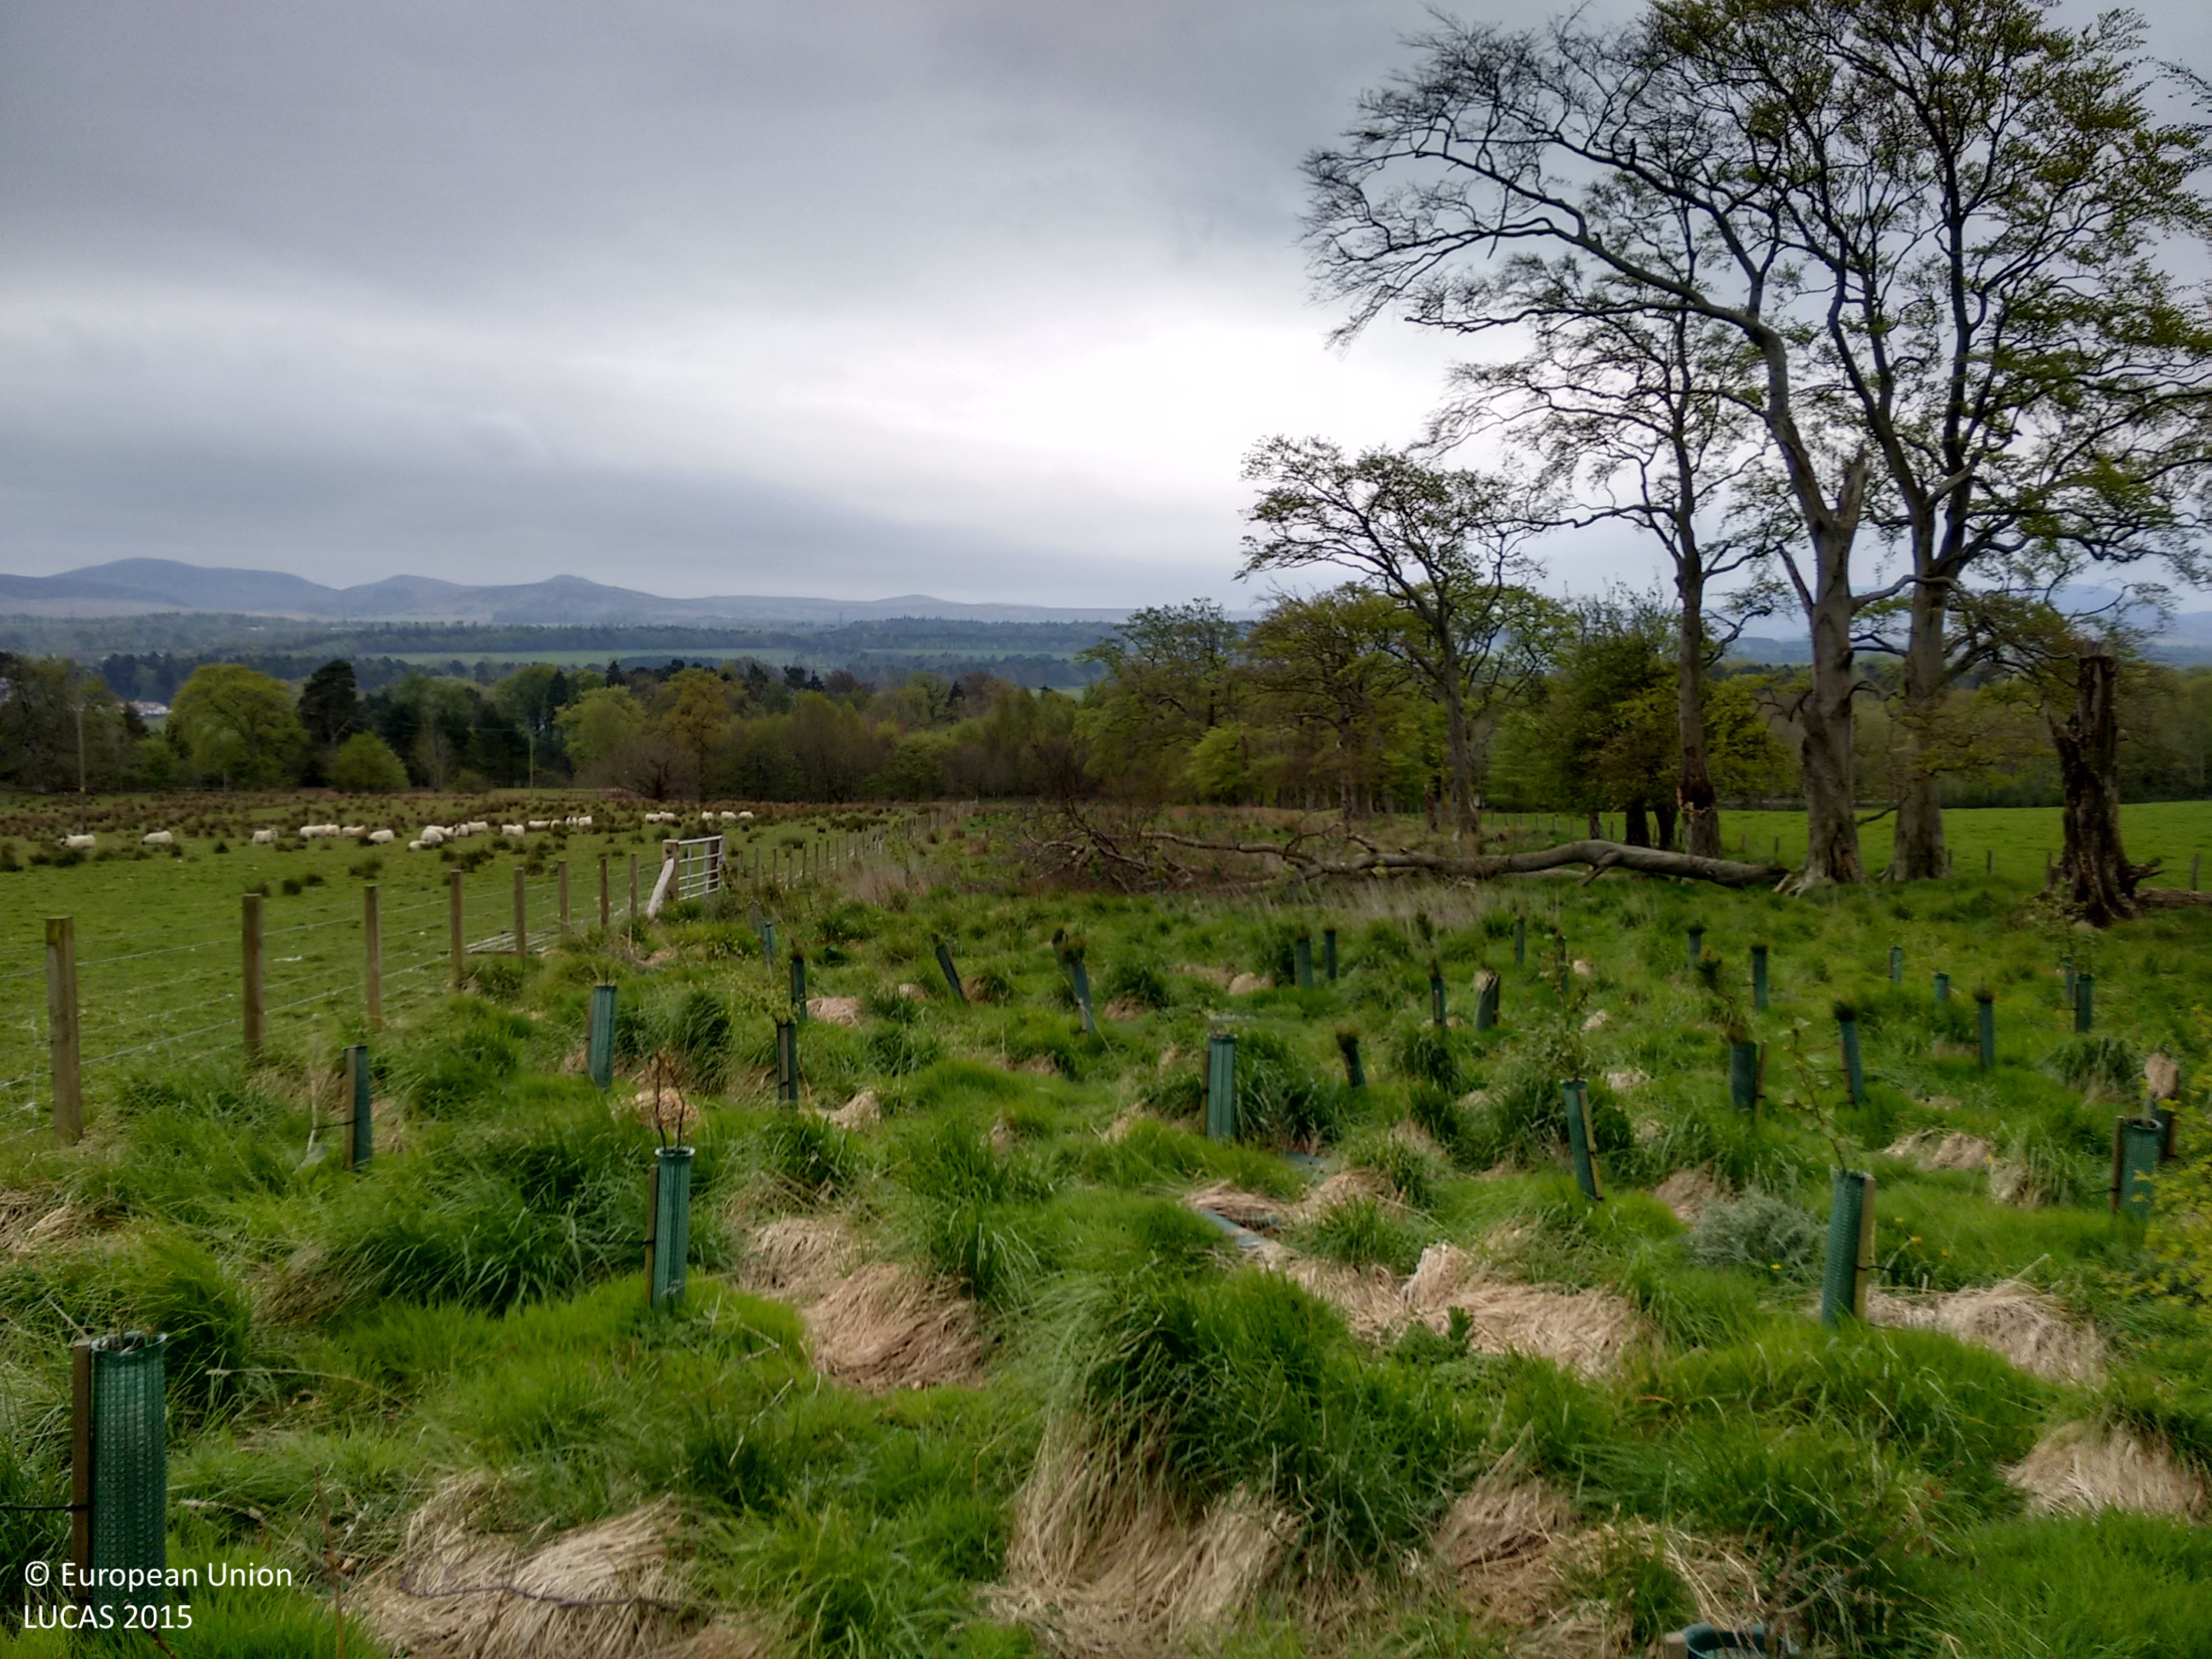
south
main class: Grassland
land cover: Grassland with sparse tree/shrub cover
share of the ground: > 75 %
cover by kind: herbaceous plants 90 %, broadleaved forest trees 5 %, shrubs 5 %
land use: Forestry
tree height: < 5 m
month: May
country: GB
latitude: 55.8864
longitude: -3.3608
